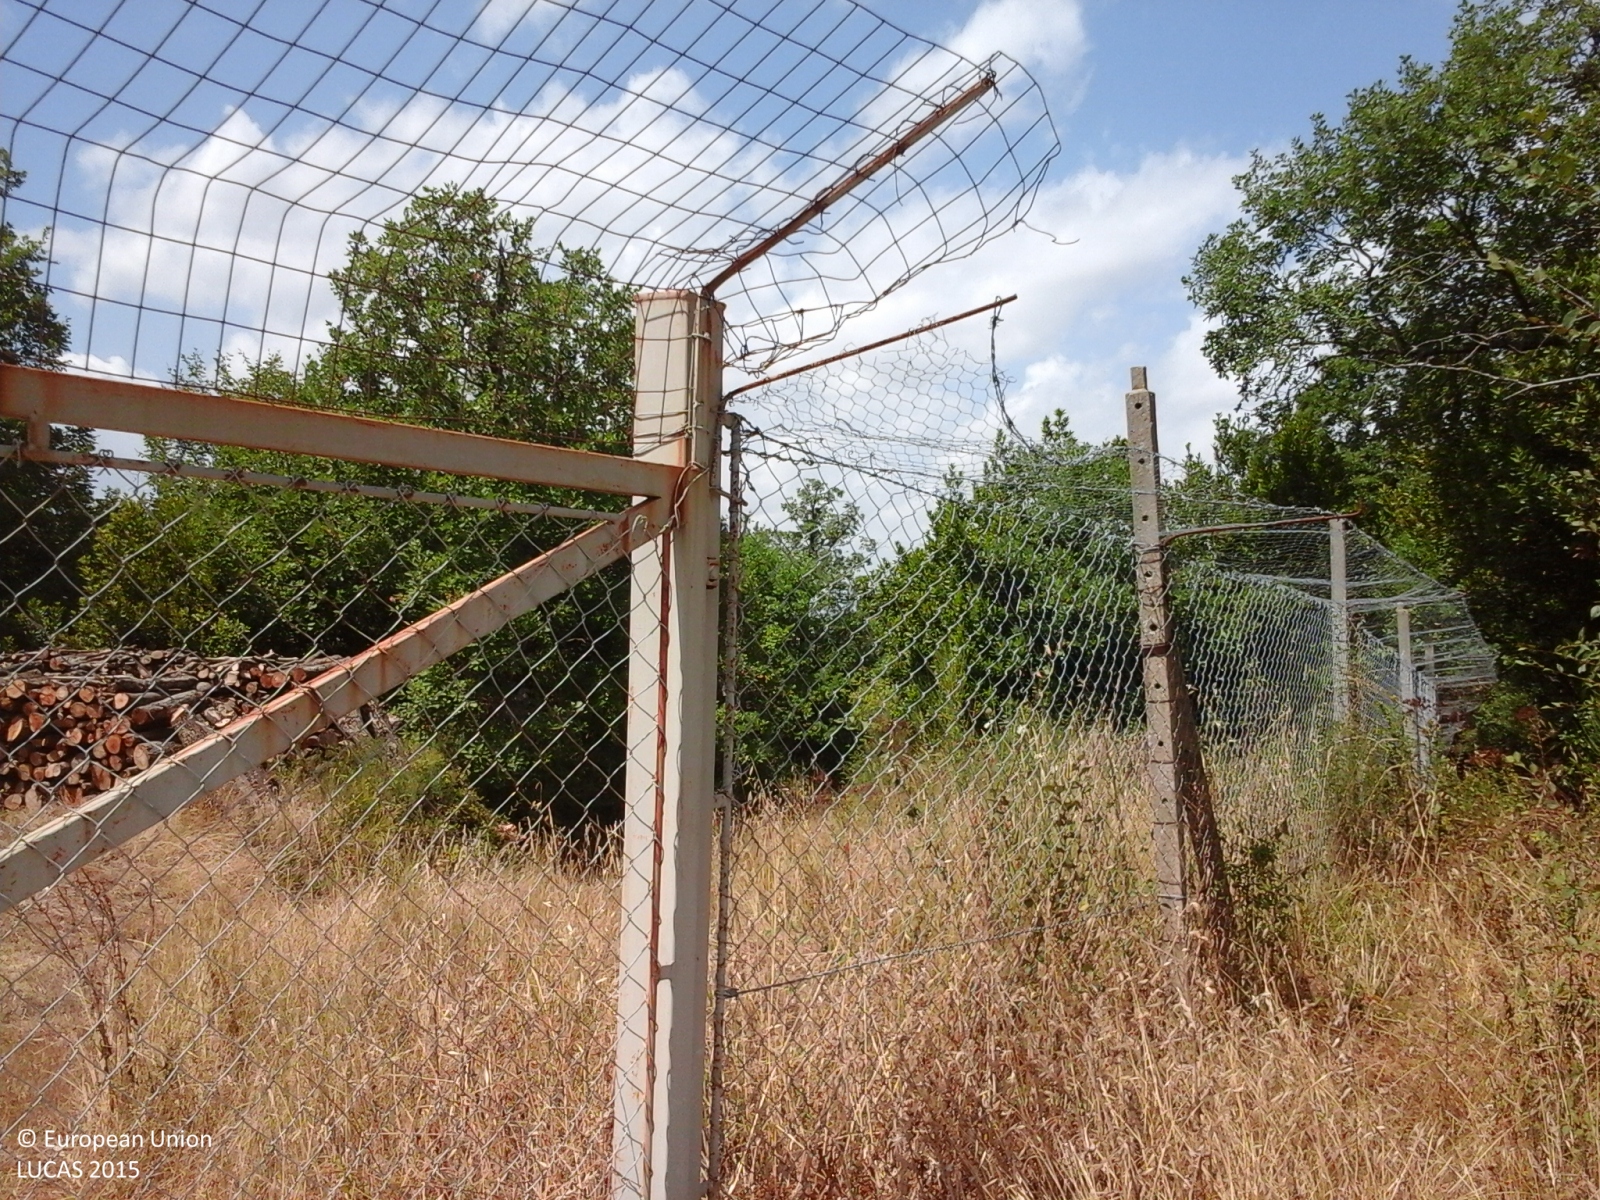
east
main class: Grassland
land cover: Grassland with sparse tree/shrub cover
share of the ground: > 75 %
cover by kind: herbaceous plants 85 %, shrubs 10 %, broadleaved forest trees 5 %
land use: Agriculture (excluding fallow land and kitchen gardens)
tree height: < 5 m
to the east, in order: Grassland with sparse tree/shrub cover; Broadleaved woodland
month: February
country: IT
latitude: 43.4443
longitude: 10.9241
